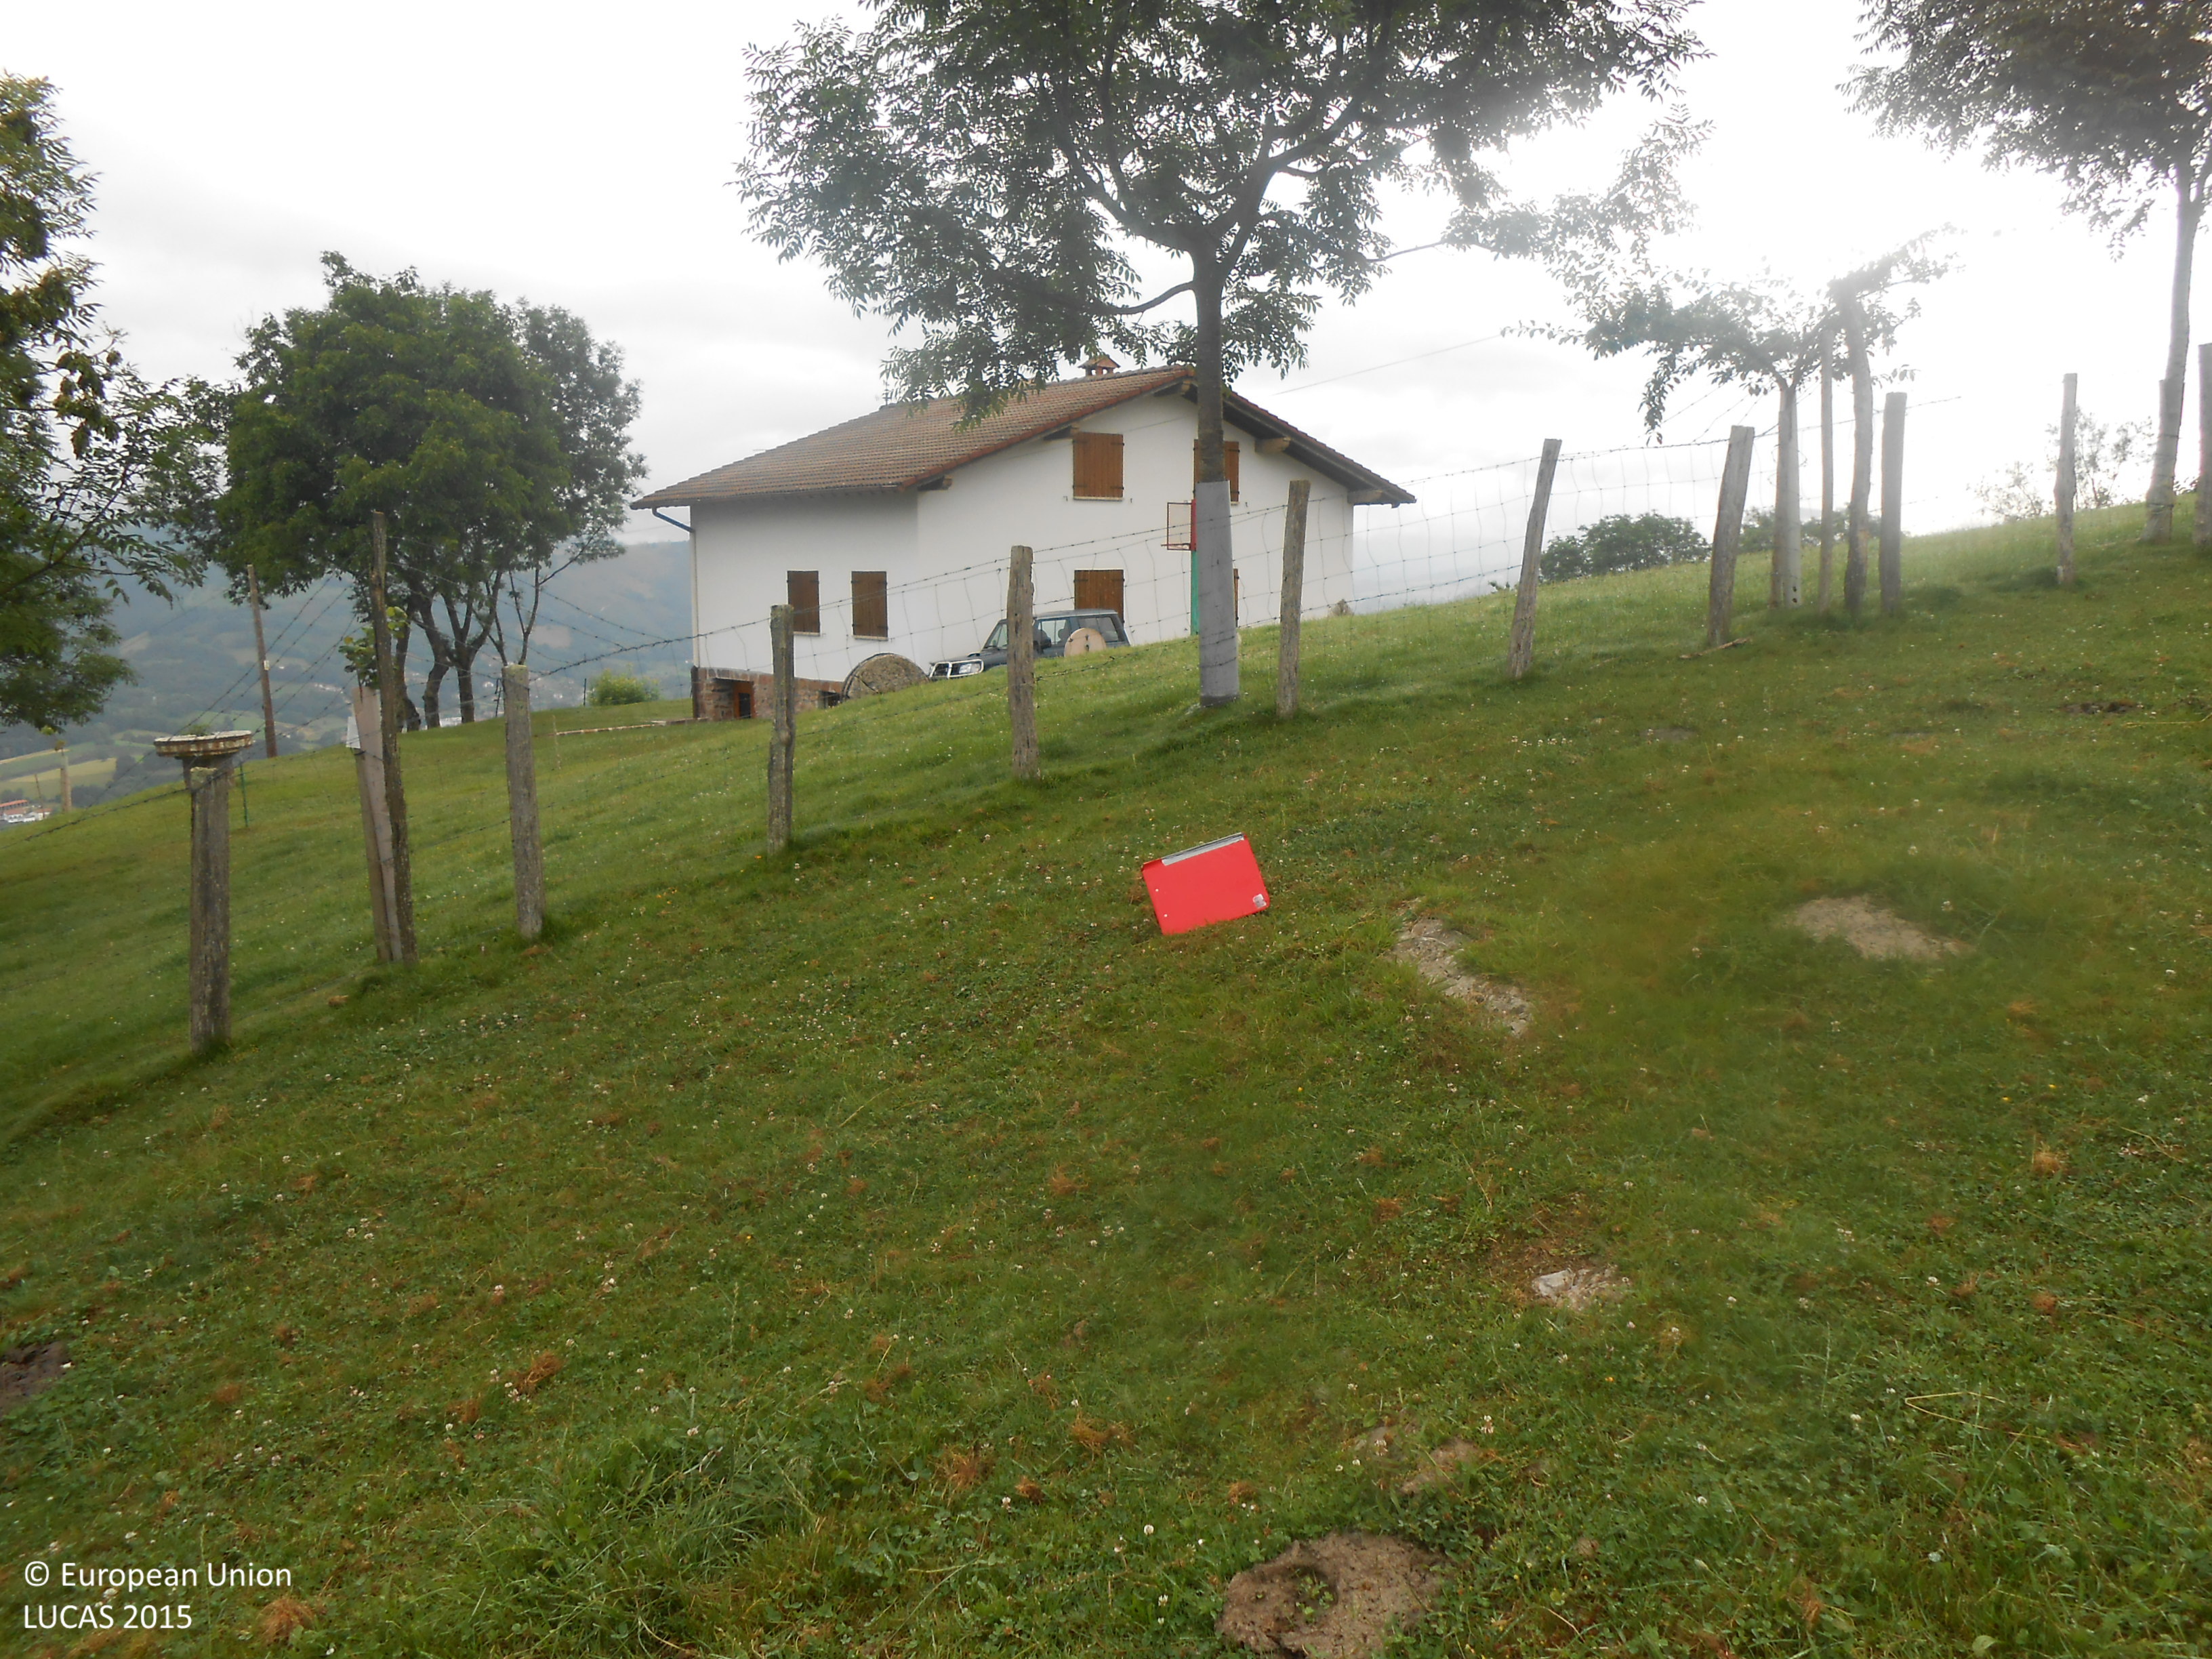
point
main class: Grassland
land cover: Grassland without tree/shrub cover
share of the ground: > 75 %
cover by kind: herbaceous plants 100 %
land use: Agriculture (excluding fallow land and kitchen gardens)
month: June
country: ES
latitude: 43.1226
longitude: -1.5328
